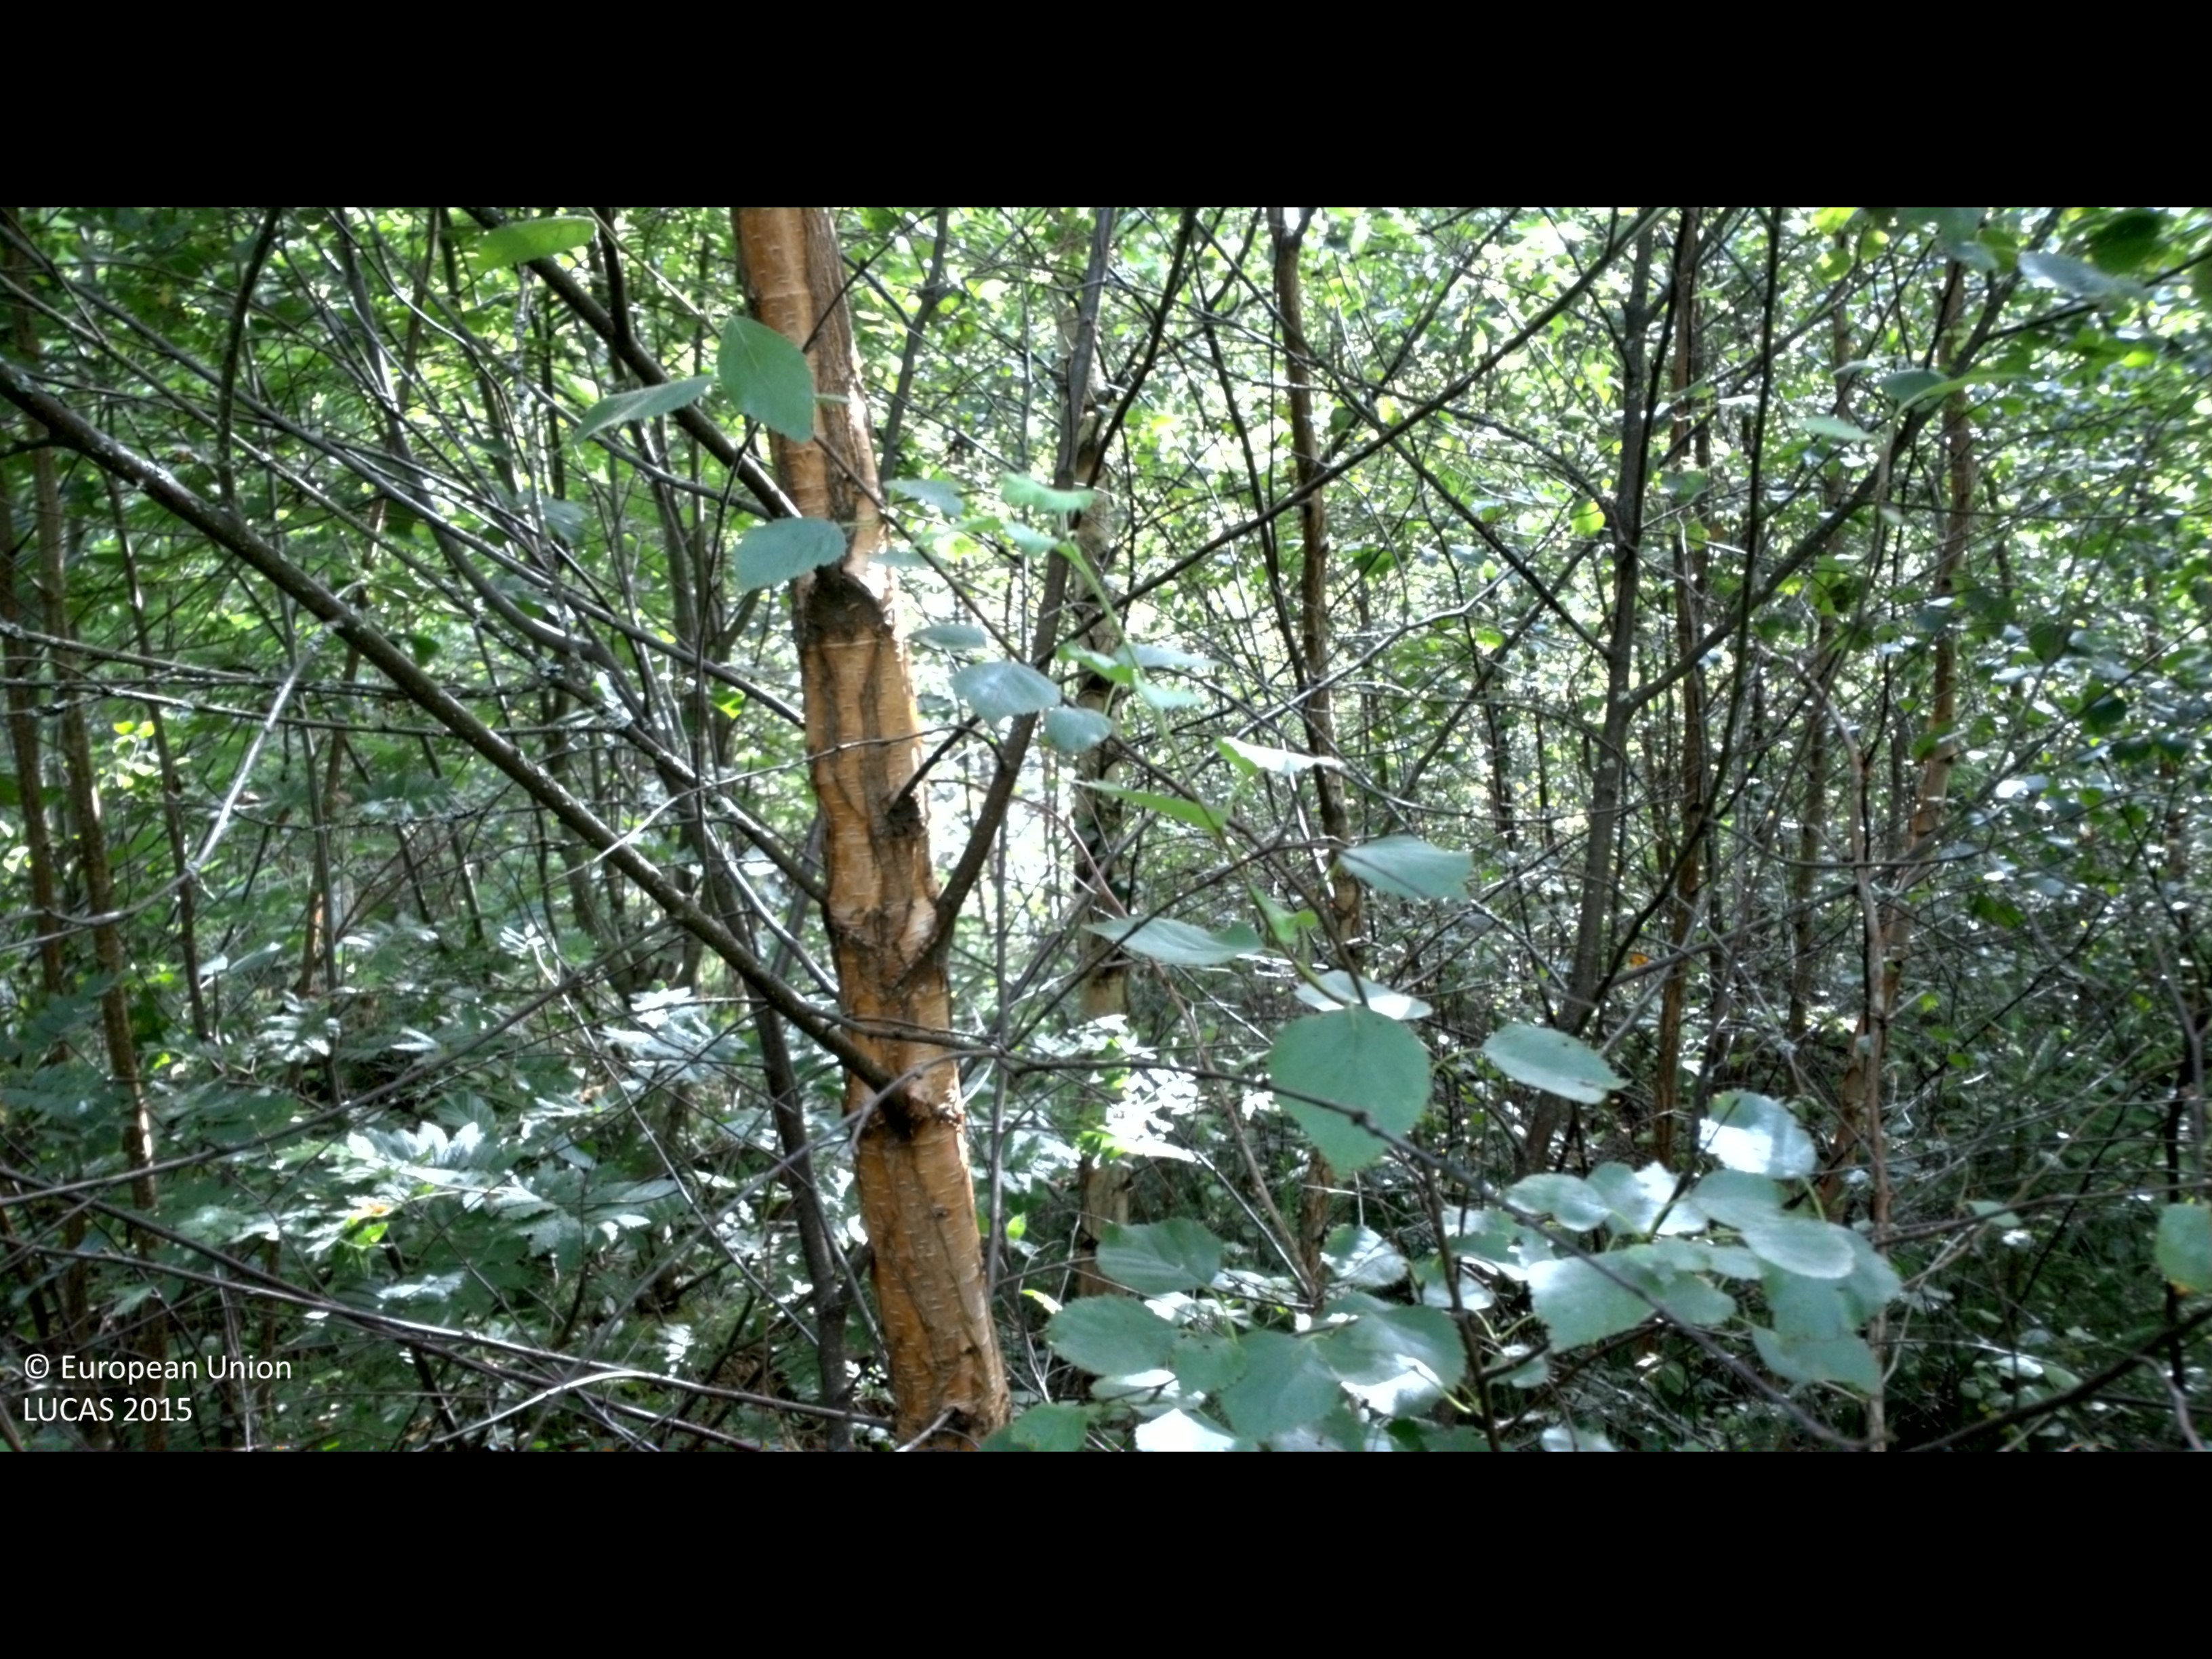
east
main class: Woodland
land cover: Broadleaved woodland
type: boreal forest
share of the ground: > 75 %
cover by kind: broadleaved forest trees 85 %, shrubs 10 %, herbaceous plants 5 %
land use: Forestry
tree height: < 5 m
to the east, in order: Broadleaved woodland; Artificial constructions in urban areas
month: August
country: SE
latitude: 56.4031
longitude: 14.3239
